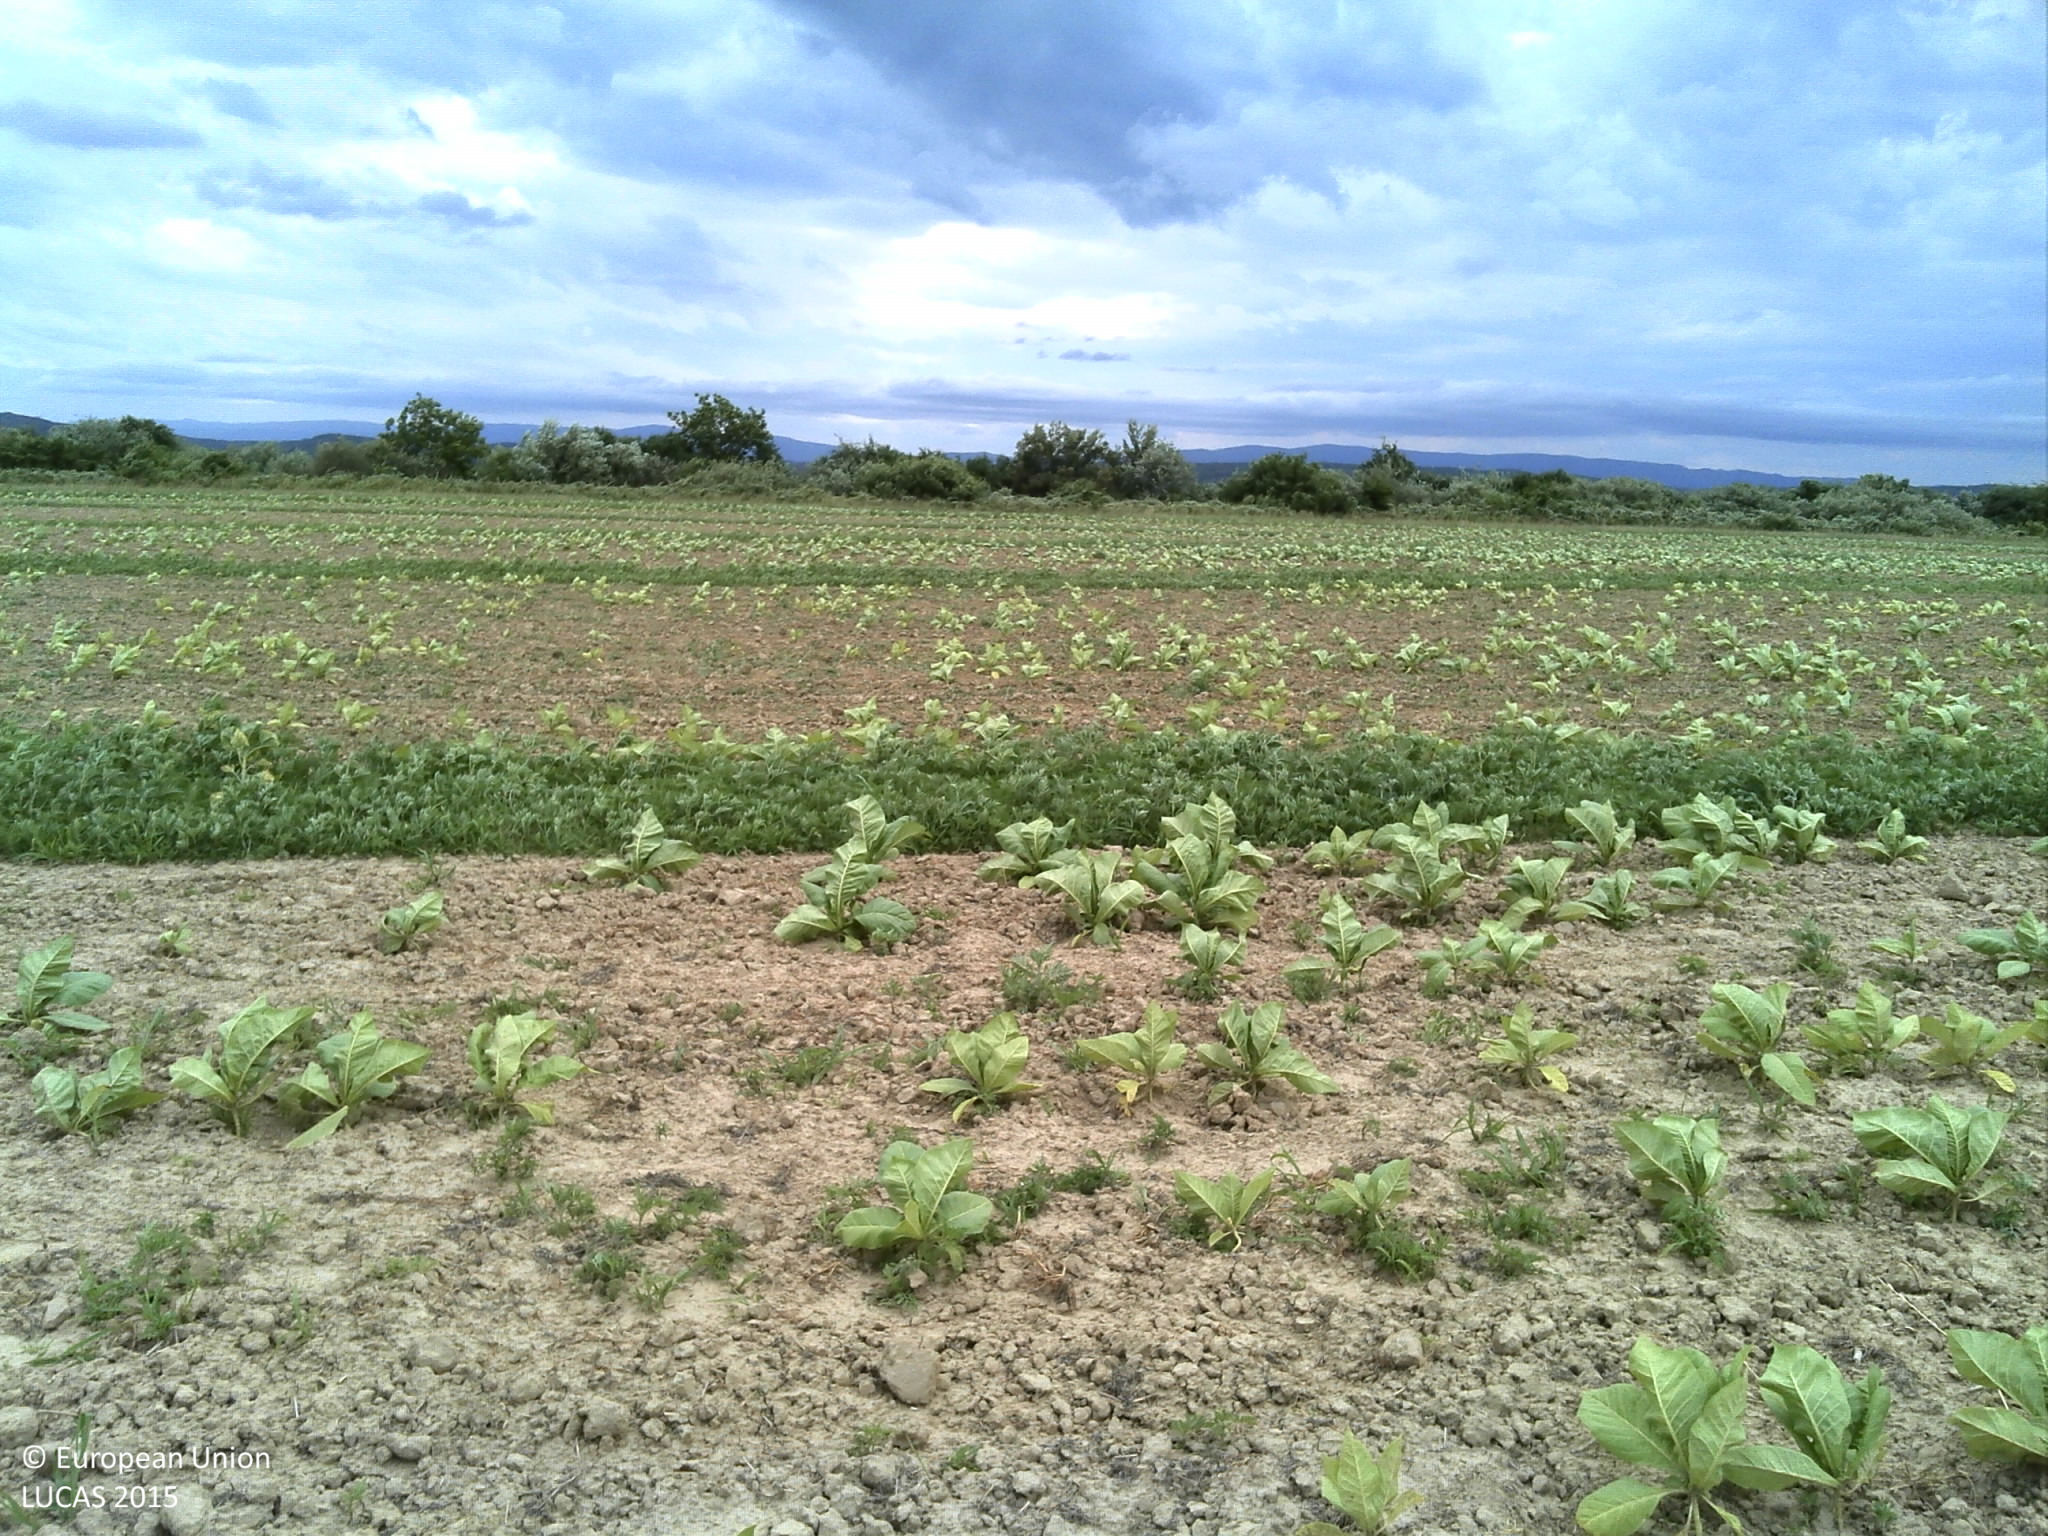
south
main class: Cropland
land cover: Tobacco
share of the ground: 10 - 25 %
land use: Agriculture (excluding fallow land and kitchen gardens)
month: June
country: HR
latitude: 45.8141
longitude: 17.5314
